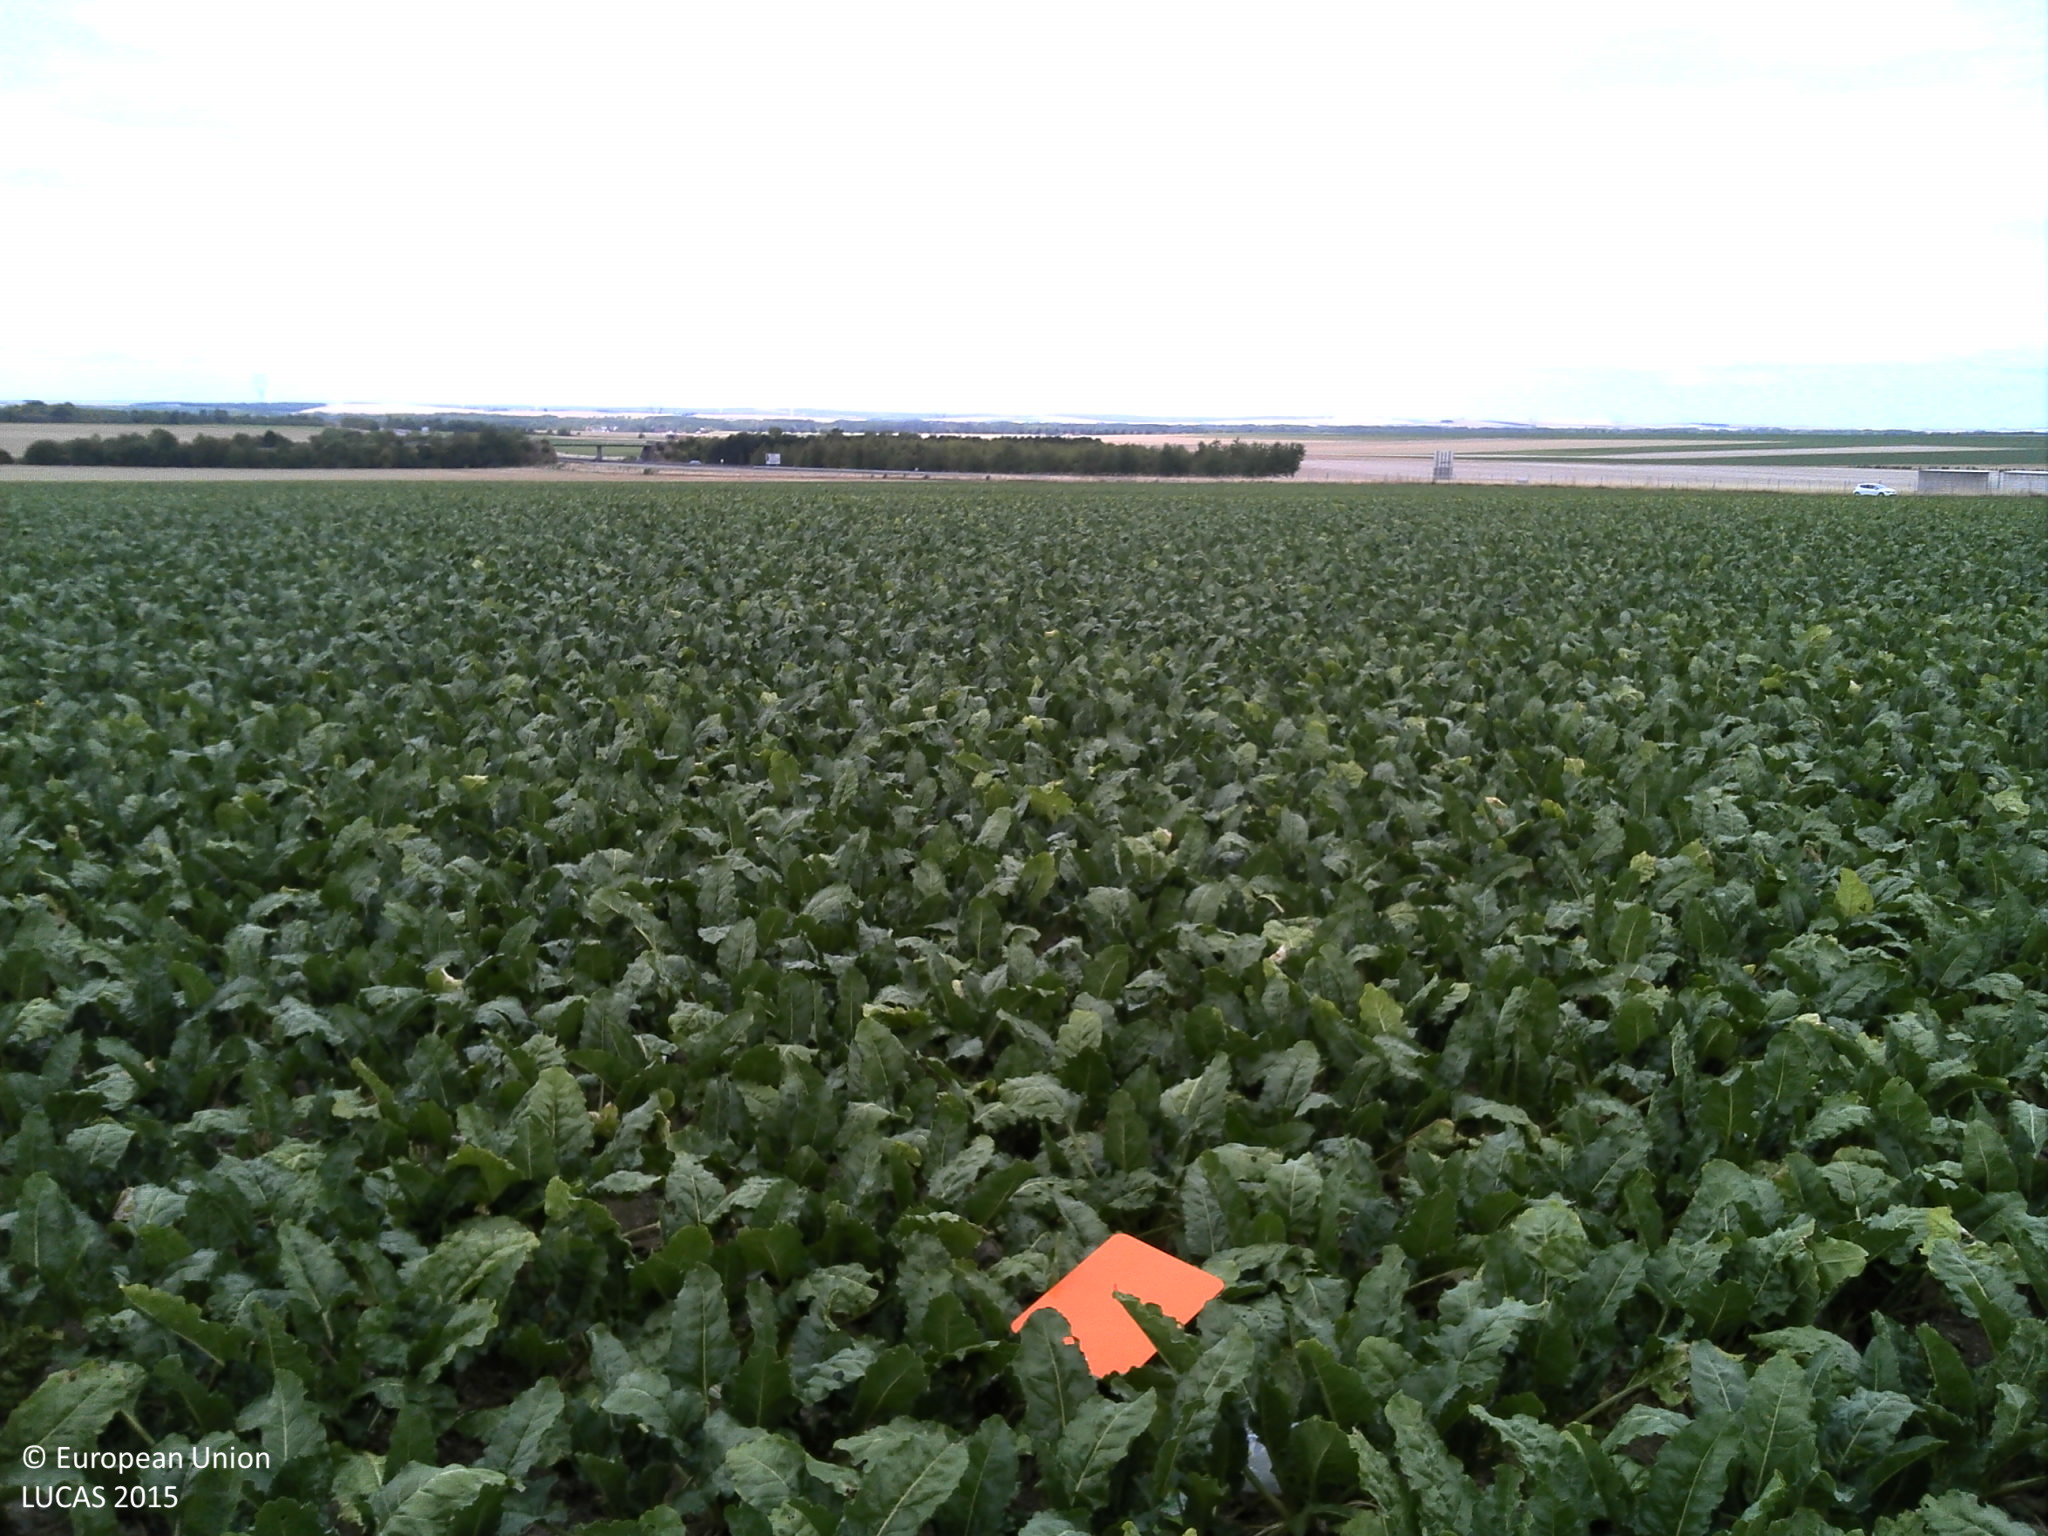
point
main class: Cropland
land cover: Sugar beet
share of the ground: > 75 %
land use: Agriculture (excluding fallow land and kitchen gardens)
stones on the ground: < 10 %
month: August
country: FR
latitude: 48.5019
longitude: 4.1630
